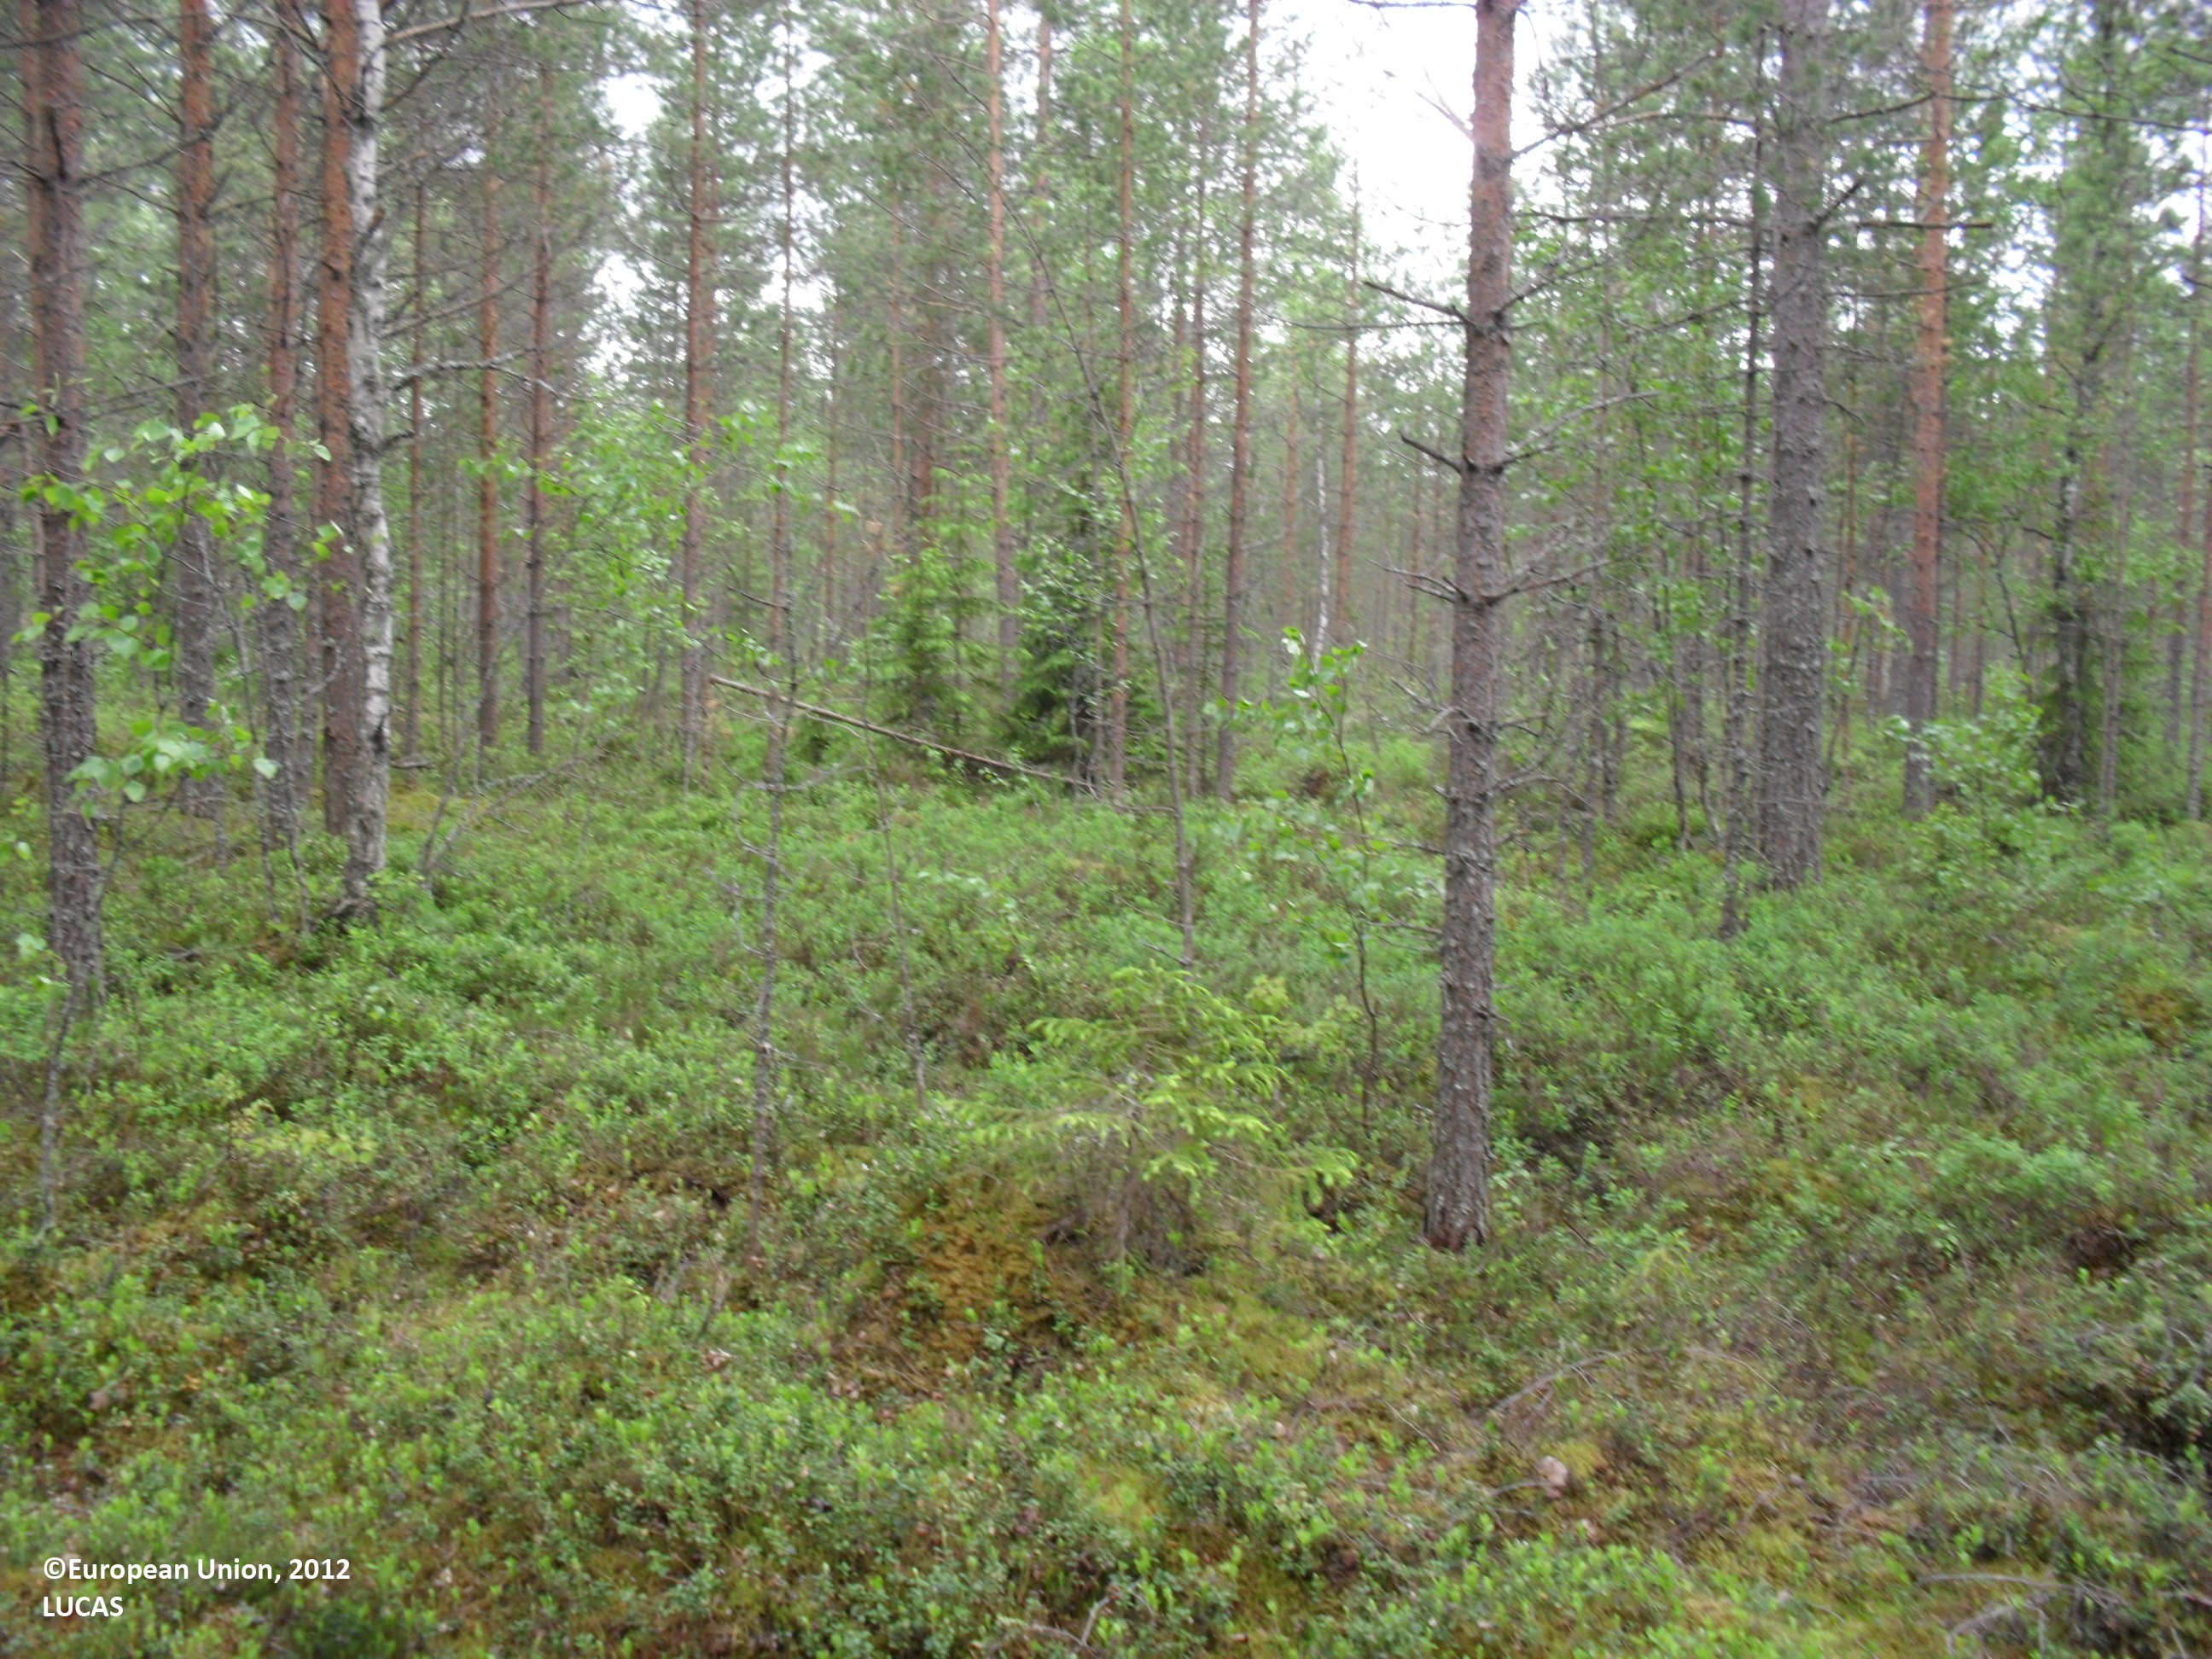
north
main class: Woodland
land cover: Pine dominated coniferous woodland
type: boreal forest
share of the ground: 50 - 75 %
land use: Forestry
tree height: > 5 m
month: June
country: FI
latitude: 63.1947
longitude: 23.2788
